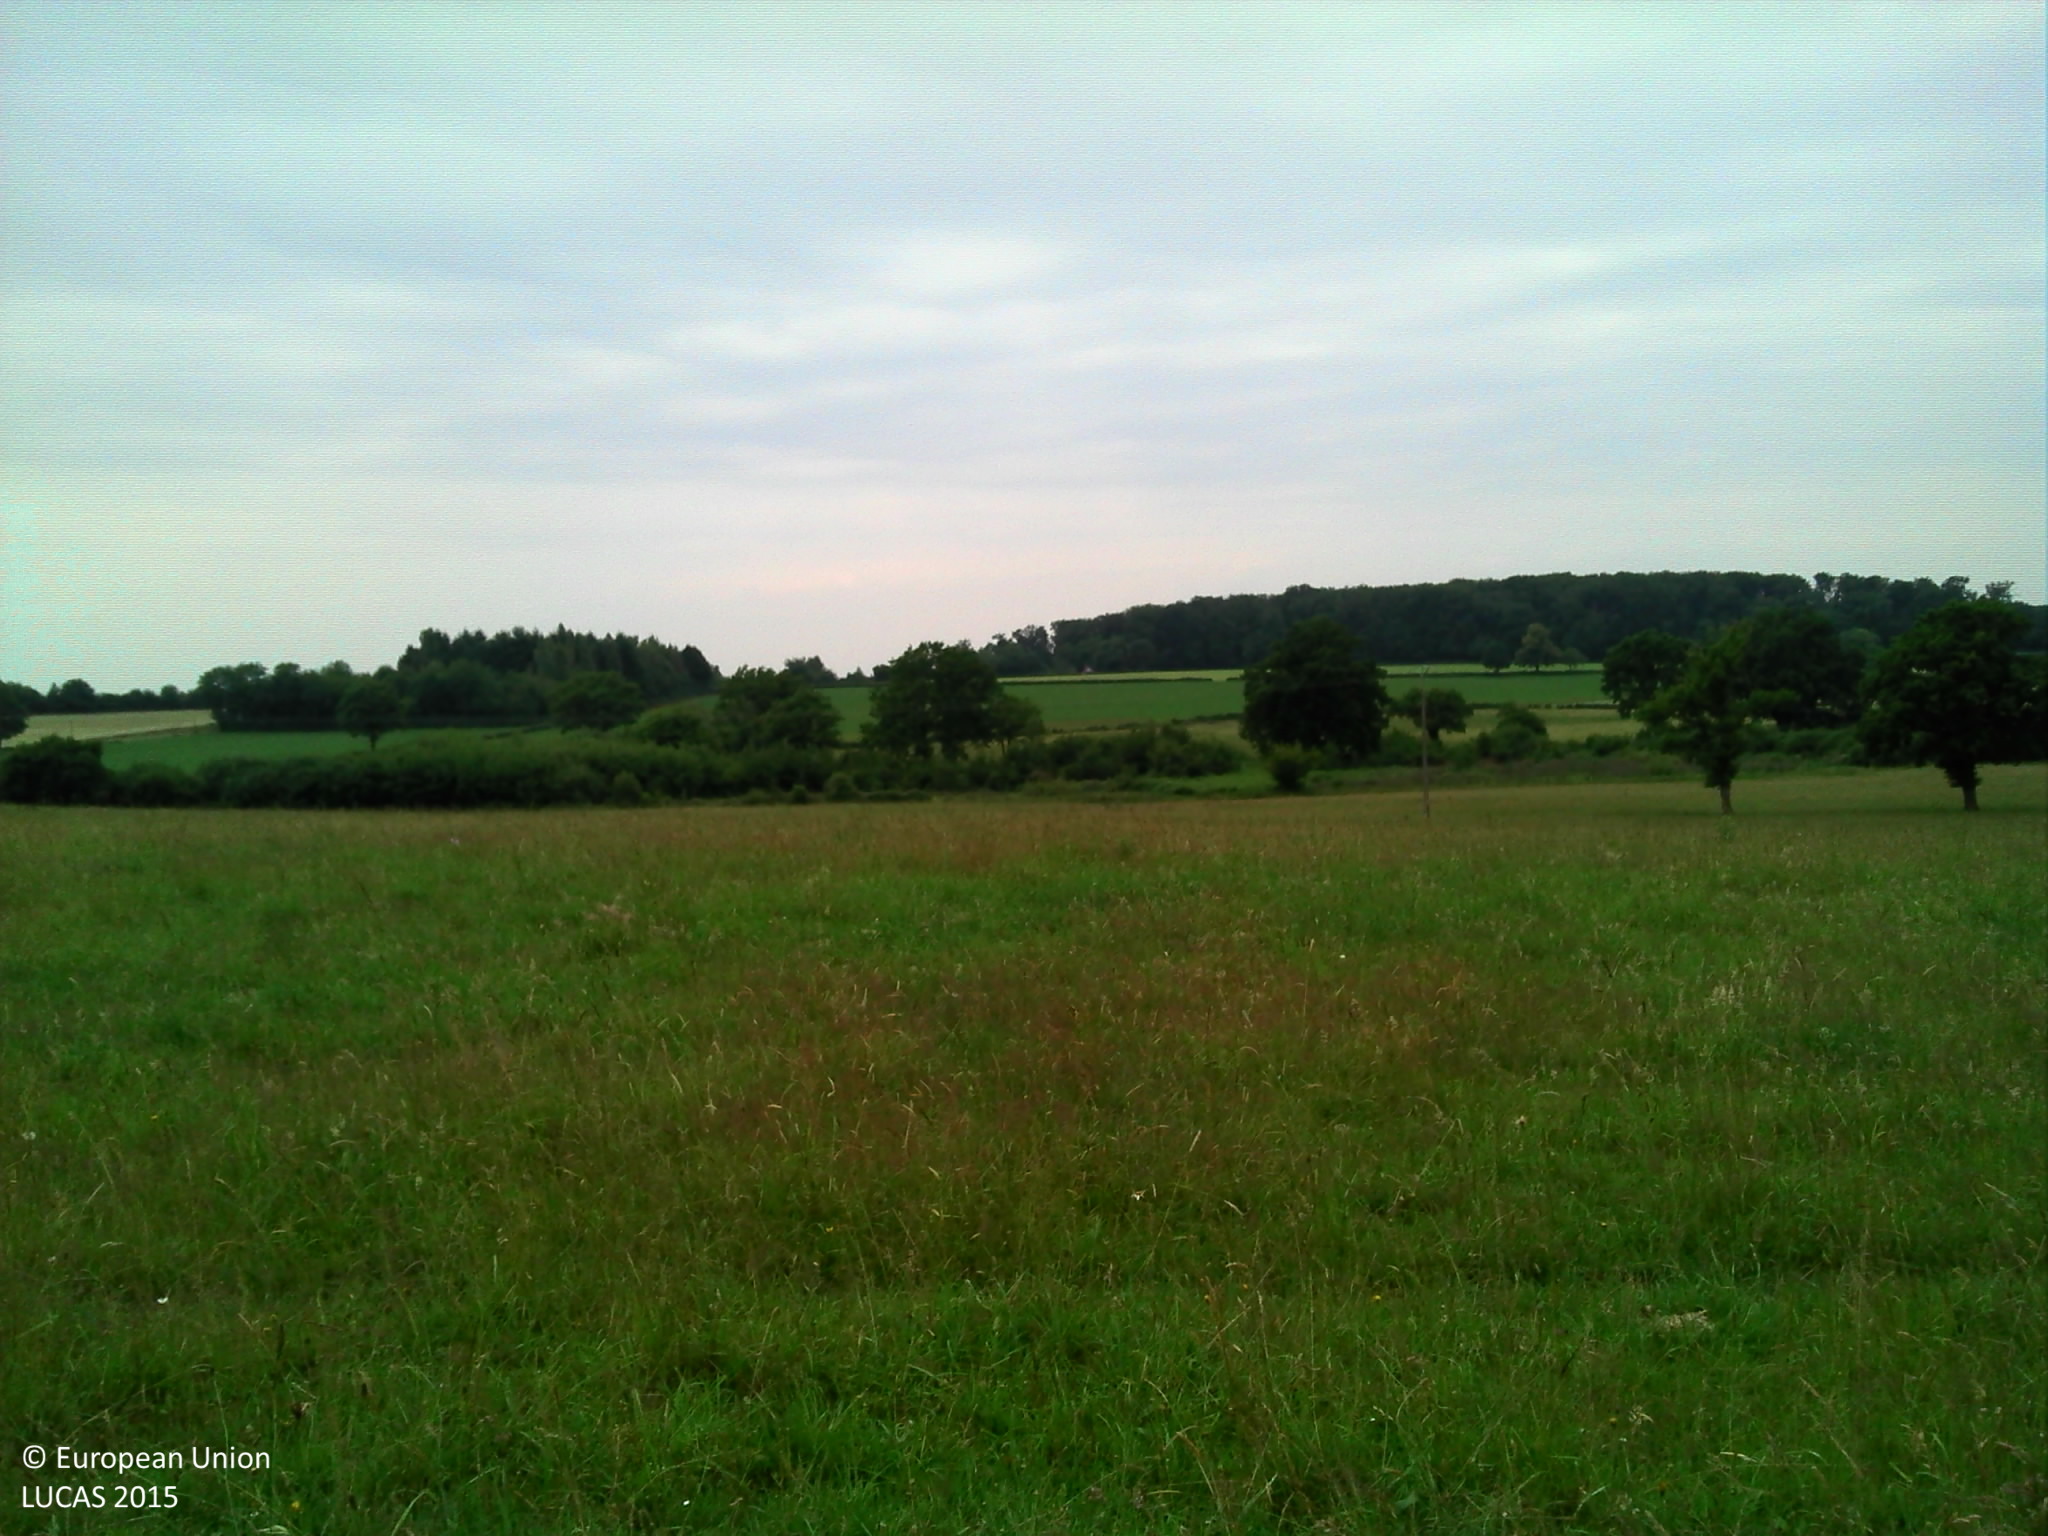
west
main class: Grassland
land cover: Grassland without tree/shrub cover
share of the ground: > 75 %
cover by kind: herbaceous plants 100 %
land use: Agriculture (excluding fallow land and kitchen gardens)
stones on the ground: < 10 %
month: June
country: FR
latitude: 46.6112
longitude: 2.7492
